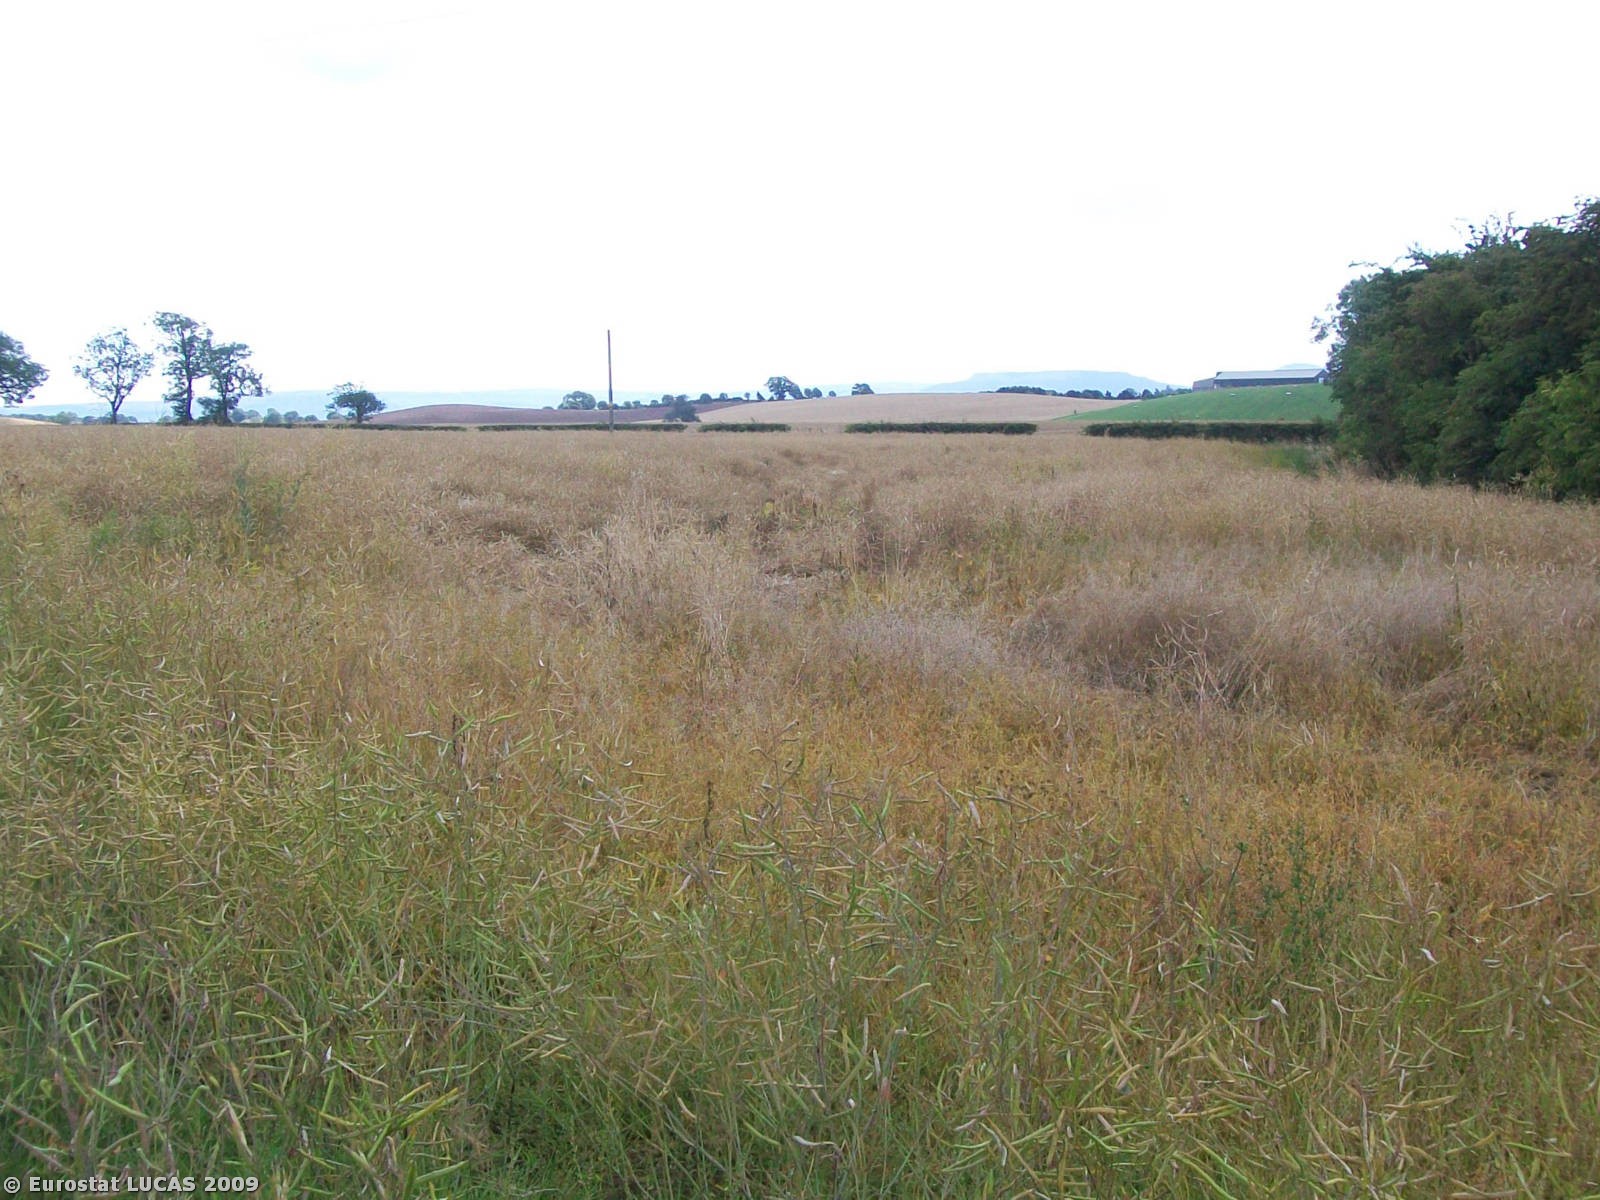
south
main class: Cropland
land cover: Rape and turnip rape
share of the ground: < 10 %
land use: Agriculture (excluding fallow land and kitchen gardens)
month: August
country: GB
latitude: 54.4933
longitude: -1.2380
